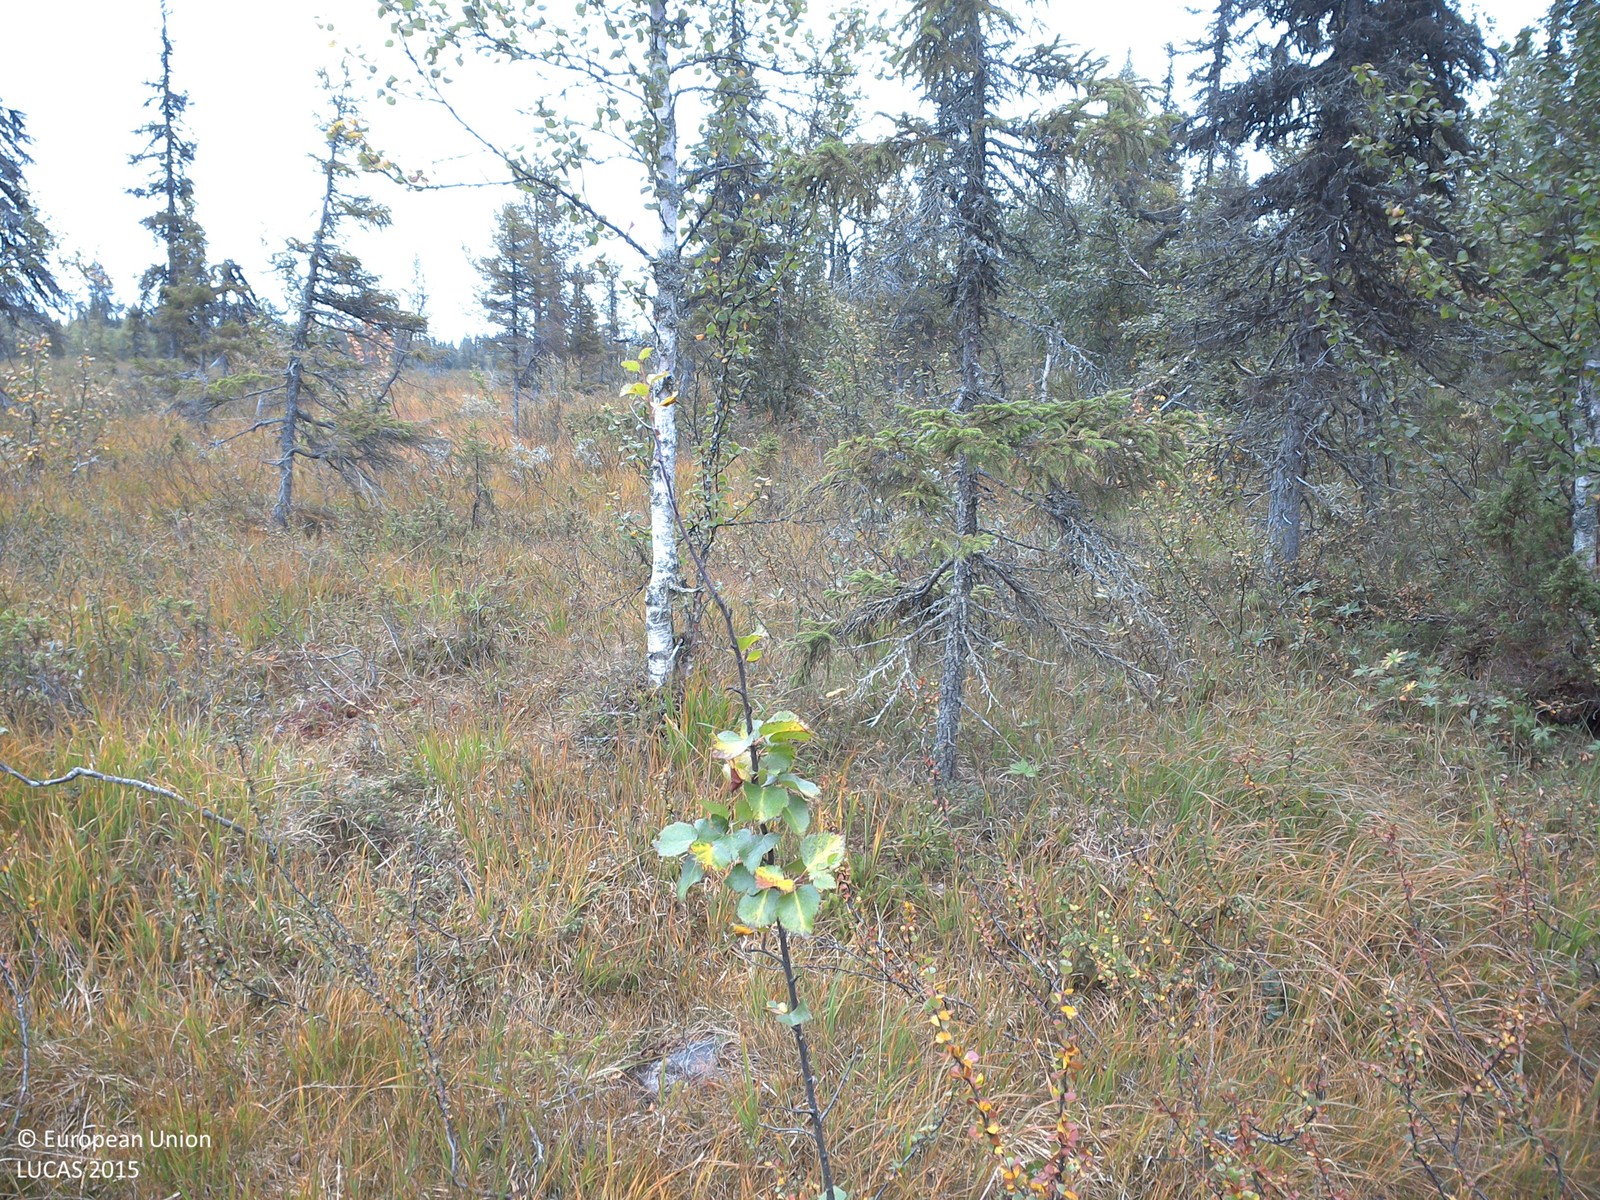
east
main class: Woodland
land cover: Spruce dominated mixed woodland
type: boreal forest
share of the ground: 25 - 50 %
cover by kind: shrubs 45 %, coniferous forest trees 20 %, herbaceous plants 20 %, broadleaved forest trees 10 %, lichens and mosses 5 %
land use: Amenities, museums, leisure
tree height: > 5 m
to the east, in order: Spruce dominated mixed woodland; Peatbogs; Spruce dominated mixed woodland; Shrubland with sparse tree cover; Inland marshes; Spruce dominated mixed woodland; Shrubland with sparse tree cover
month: August
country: SE
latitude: 67.8769
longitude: 21.5805
